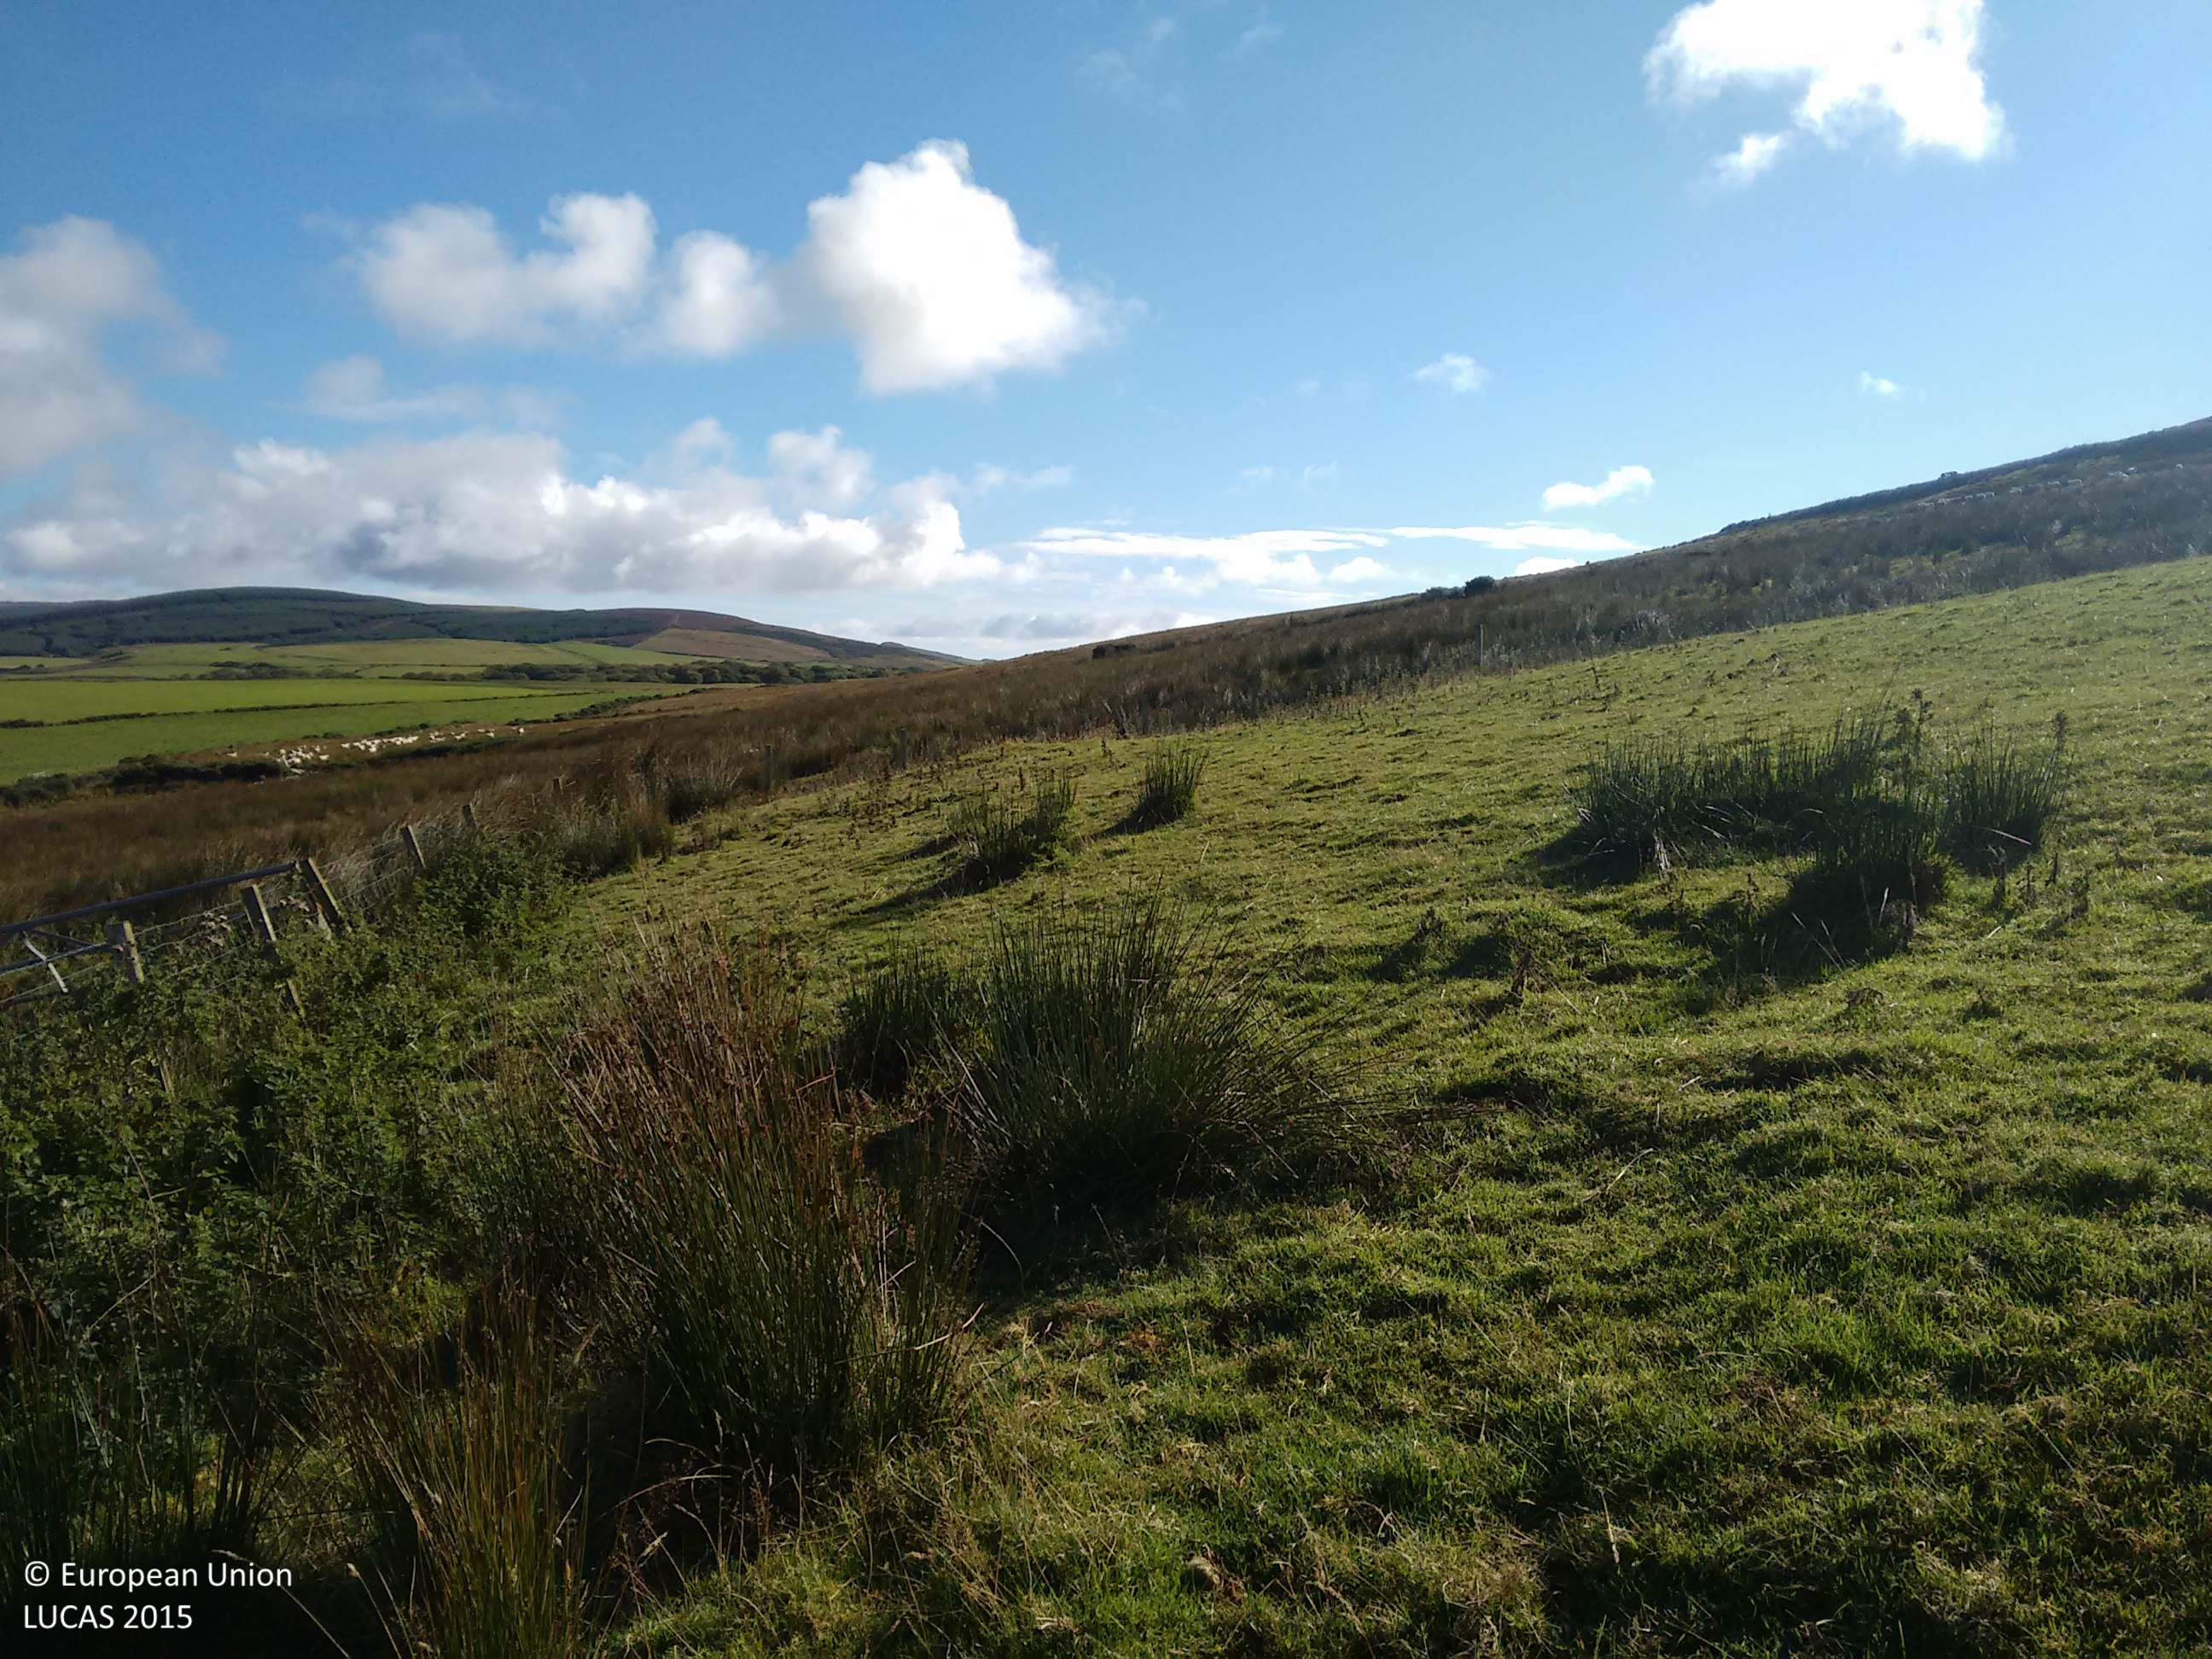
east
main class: Grassland
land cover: Grassland without tree/shrub cover
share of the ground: > 75 %
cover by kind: herbaceous plants 100 %
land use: Agriculture (excluding fallow land and kitchen gardens)
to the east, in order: Grassland without tree/shrub cover; Fences; Grassland without tree/shrub cover; Rivers and streams; Grassland without tree/shrub cover; Dry stone walls; Single bushes/trees; Grassland without tree/shrub cover; Ditches and canals; Grassland without tree/shrub cover
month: September
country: GB
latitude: 55.3281
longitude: -5.6547
